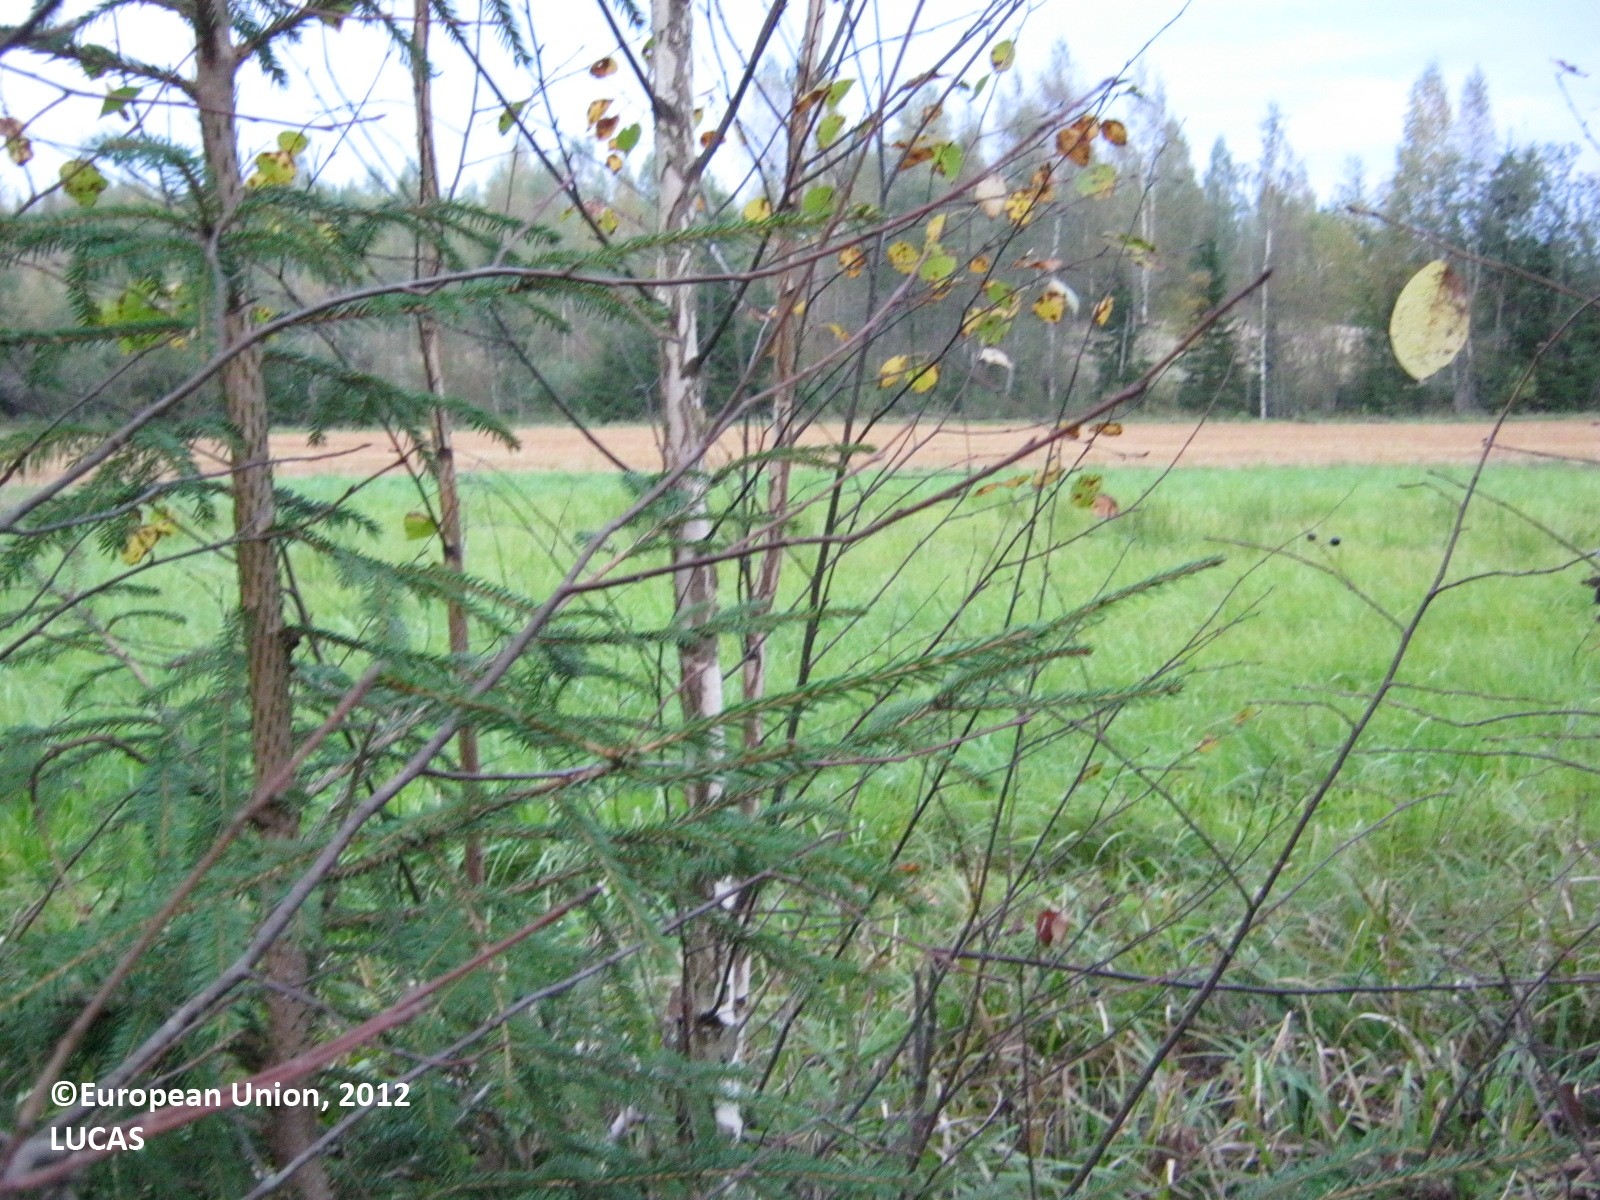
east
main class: Woodland
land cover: Broadleaved woodland
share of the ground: > 75 %
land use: Forestry
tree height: < 5 m
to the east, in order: Broadleaved woodland; Ditches and canals; Grassland without tree/shrub cover; Ditches and canals; Shruby margins; Oats; Shruby margins; Ditches and canals; Broadleaved woodland; Ditches and canals; Tracks; Broadleaved woodland; Common wheat; Sugar beet; Other fresh vegetables; Common wheat
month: September
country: FI
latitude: 61.0083
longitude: 28.1639
